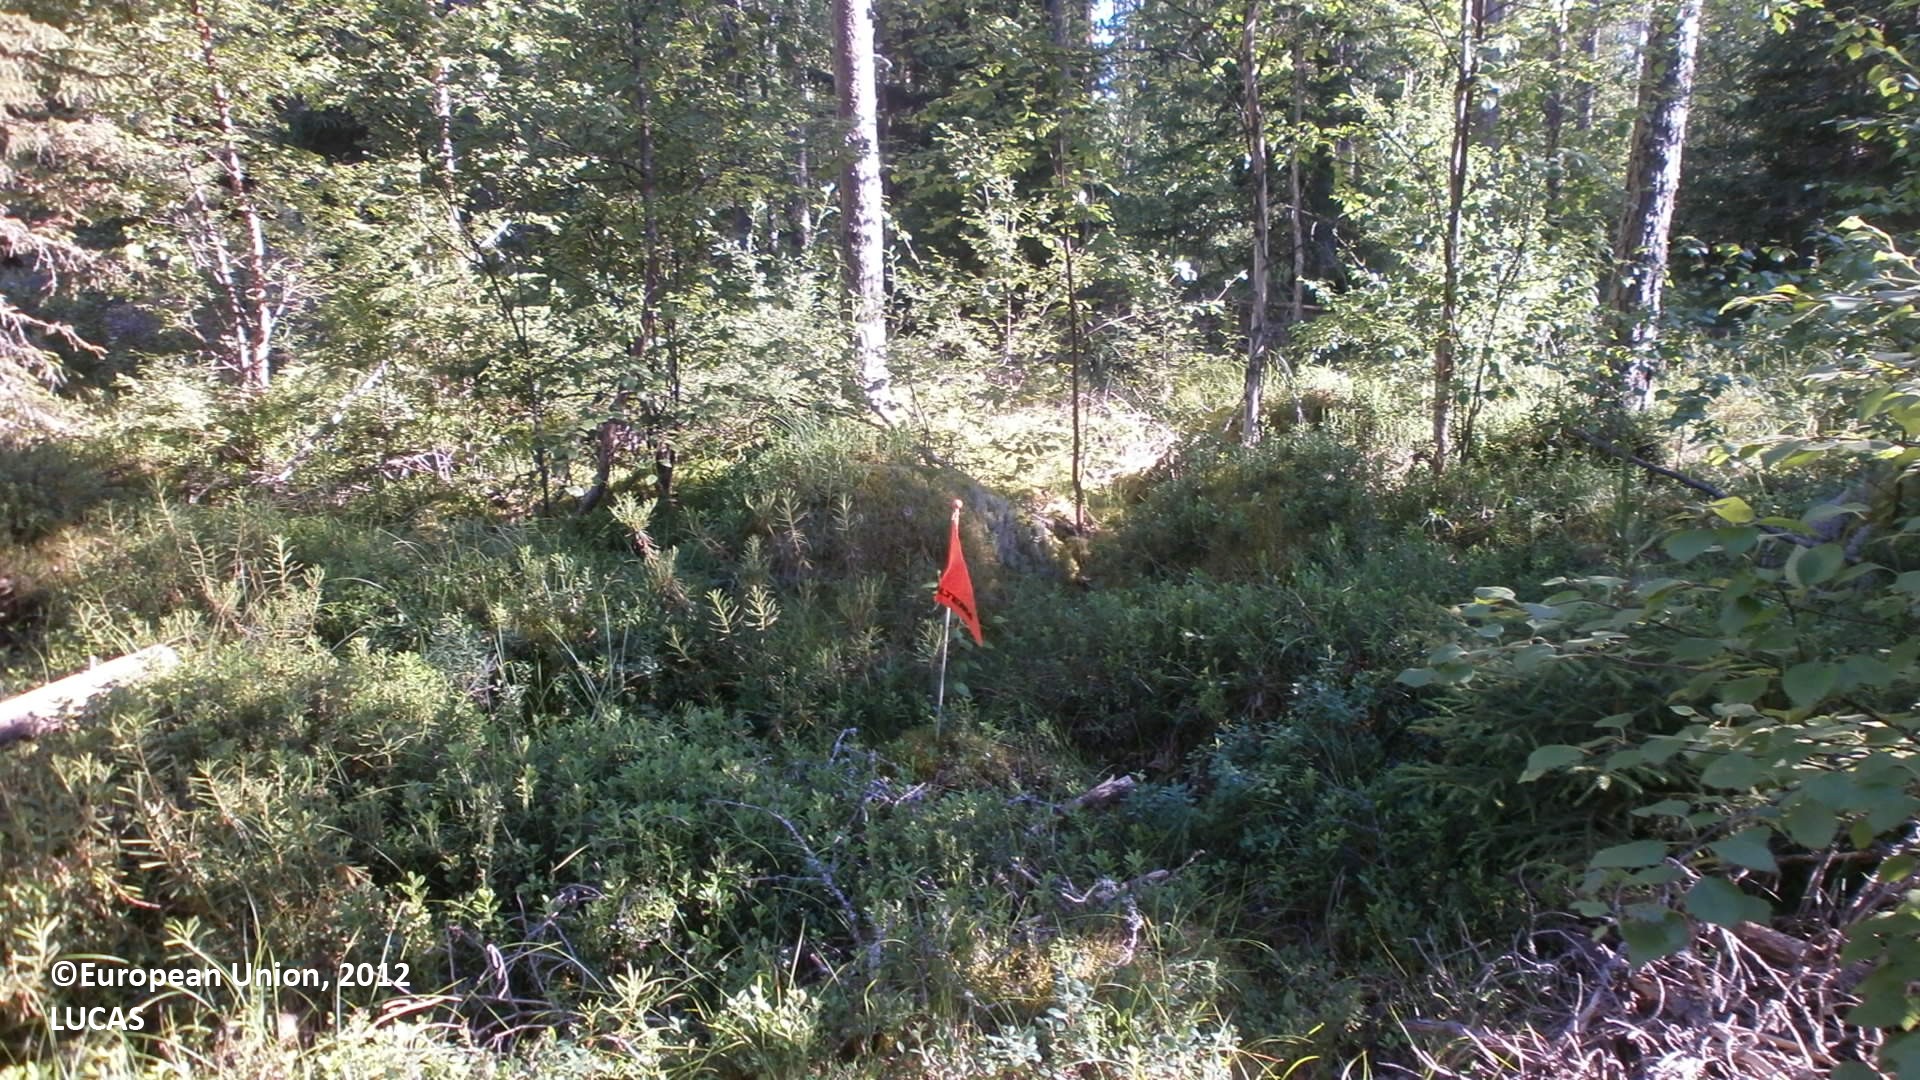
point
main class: Woodland
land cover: Pine dominated coniferous woodland
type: boreal forest
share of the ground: 50 - 75 %
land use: Forestry
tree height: > 5 m
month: July
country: FI
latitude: 64.0344
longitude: 23.9642
